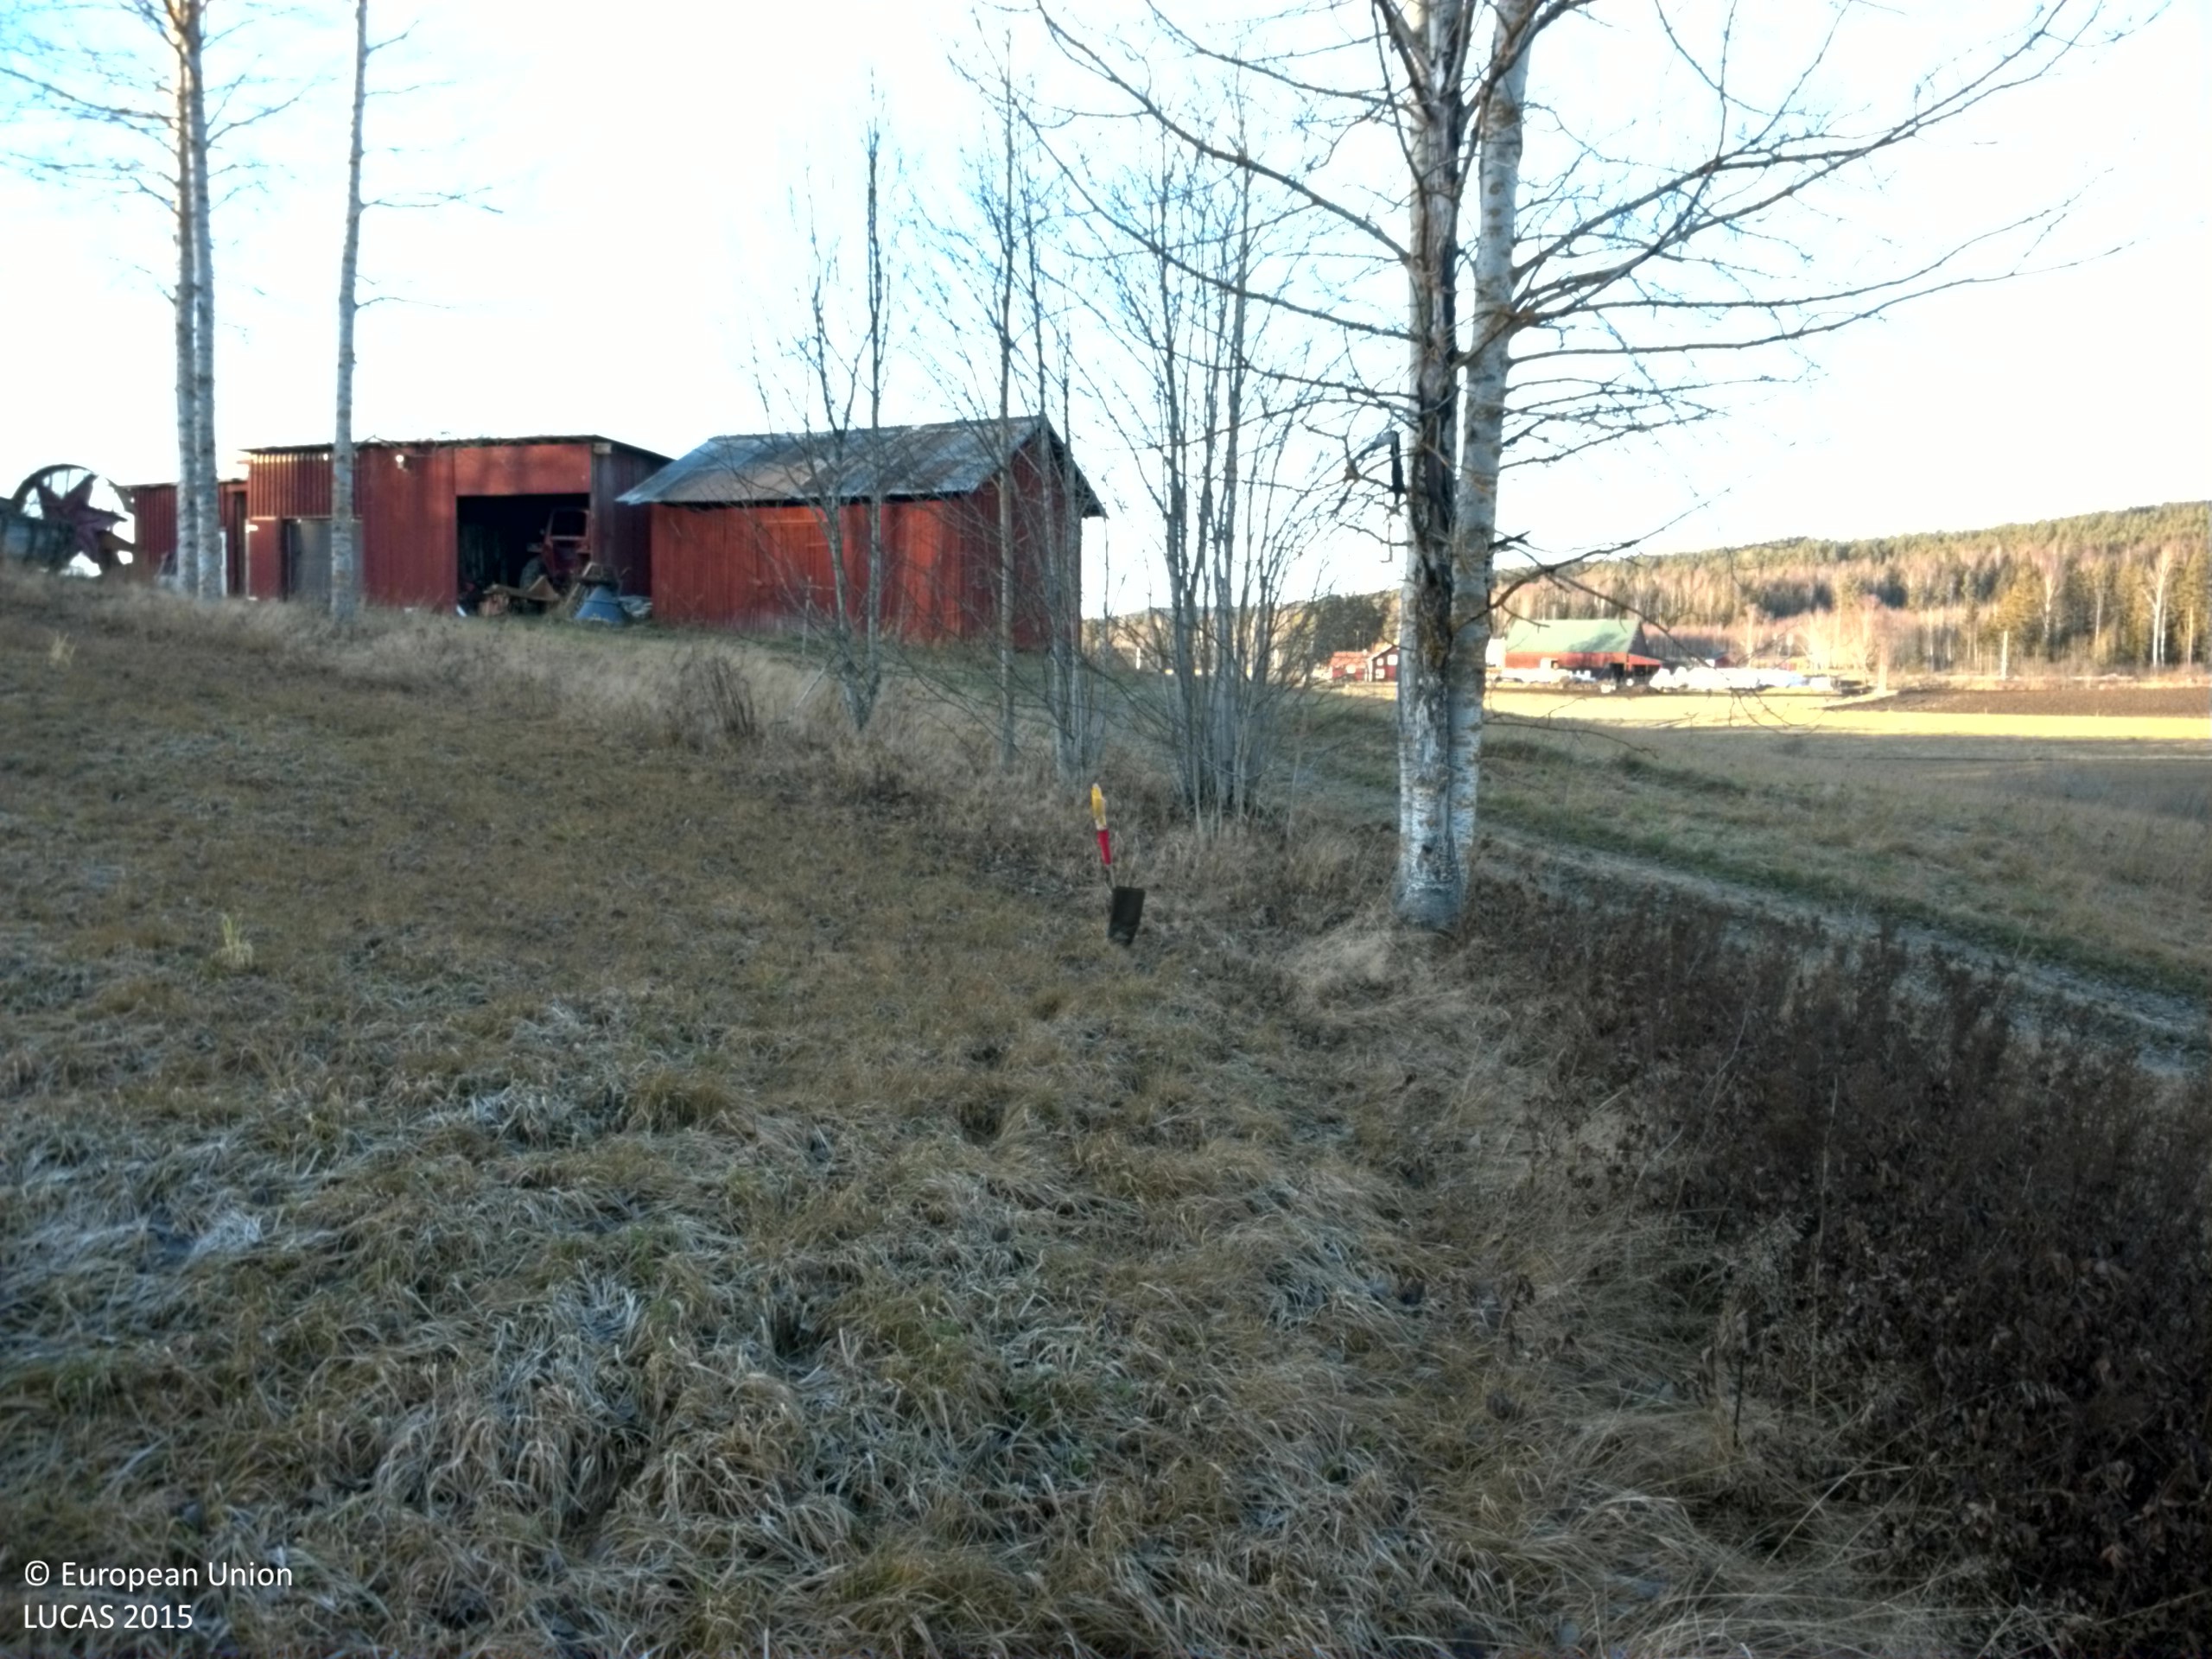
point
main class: Cropland
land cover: Temporary grasslands
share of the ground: > 75 %
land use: Agriculture (excluding fallow land and kitchen gardens)
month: November
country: SE
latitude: 61.2699
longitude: 16.6805
